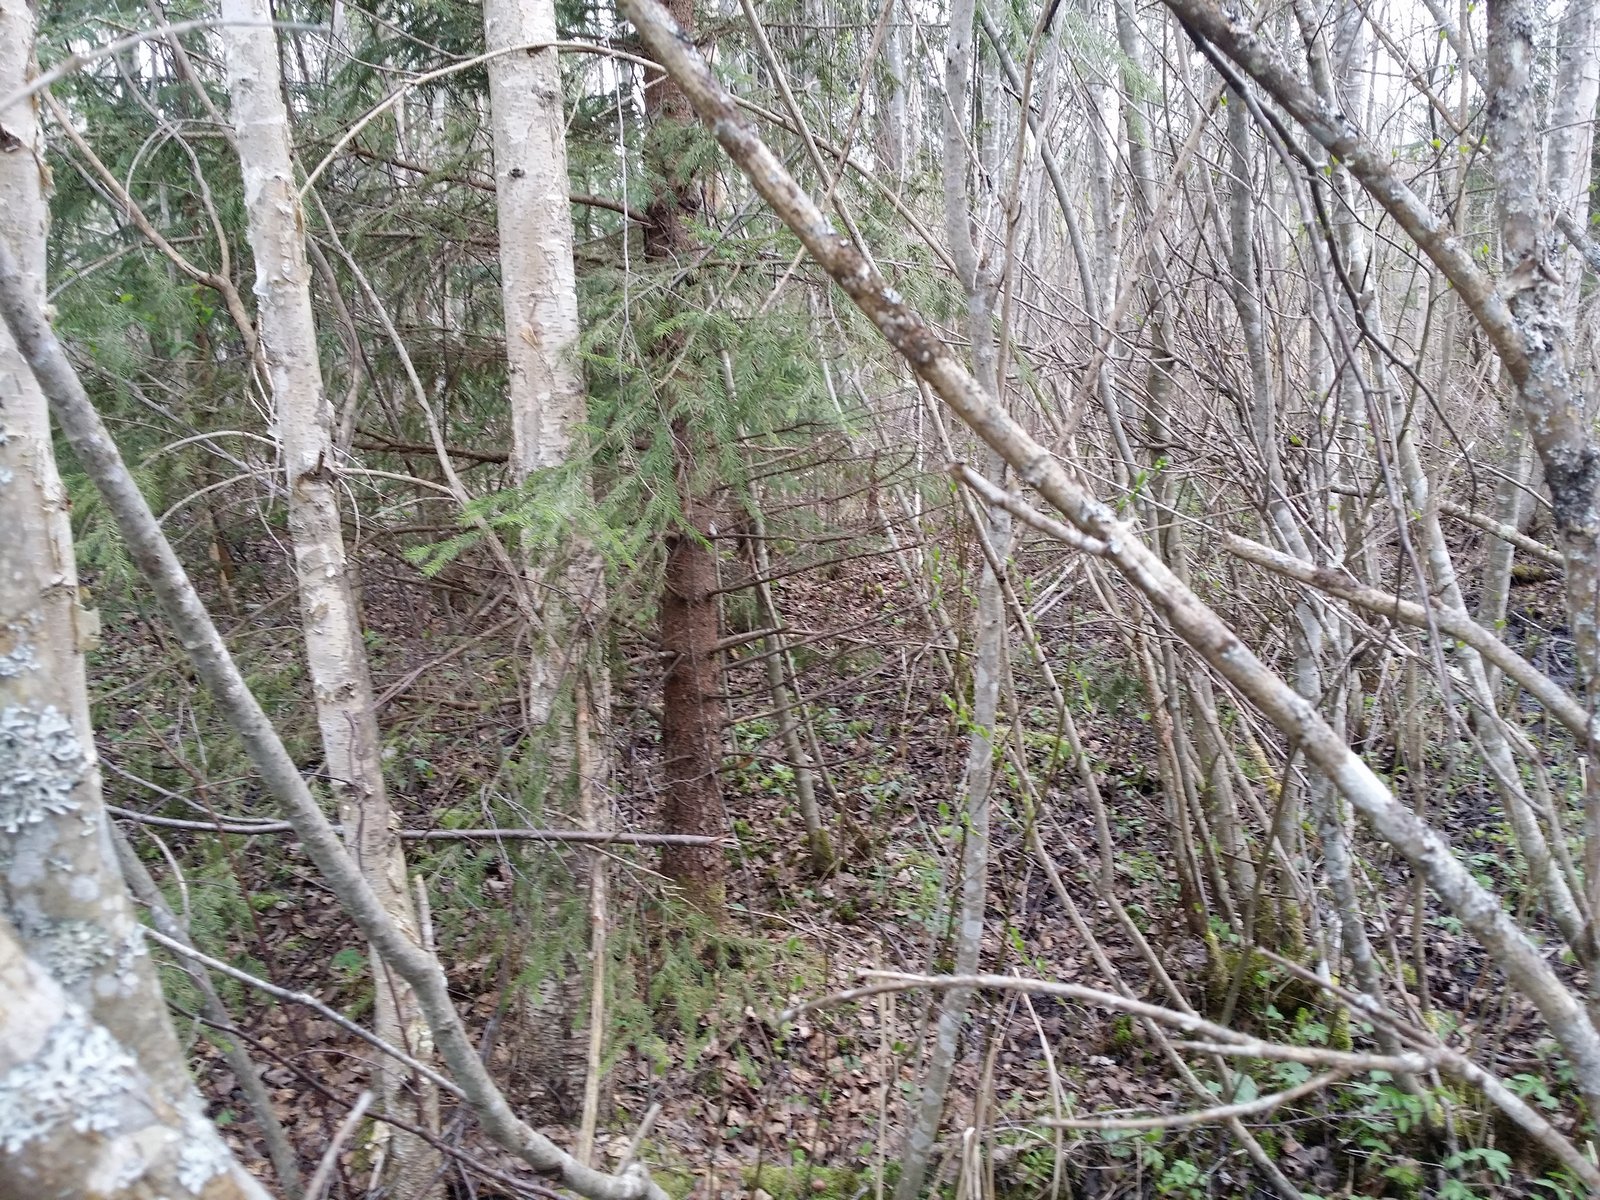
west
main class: Woodland
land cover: Broadleaved woodland
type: mire and swamp forests
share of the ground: > 75 %
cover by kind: broadleaved forest trees 70 %, coniferous forest trees 20 %, lichens and mosses 10 %
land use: Semi-natural and natural areas not in use
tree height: < 5 m
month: May
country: LV
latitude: 57.4697
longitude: 26.0188
